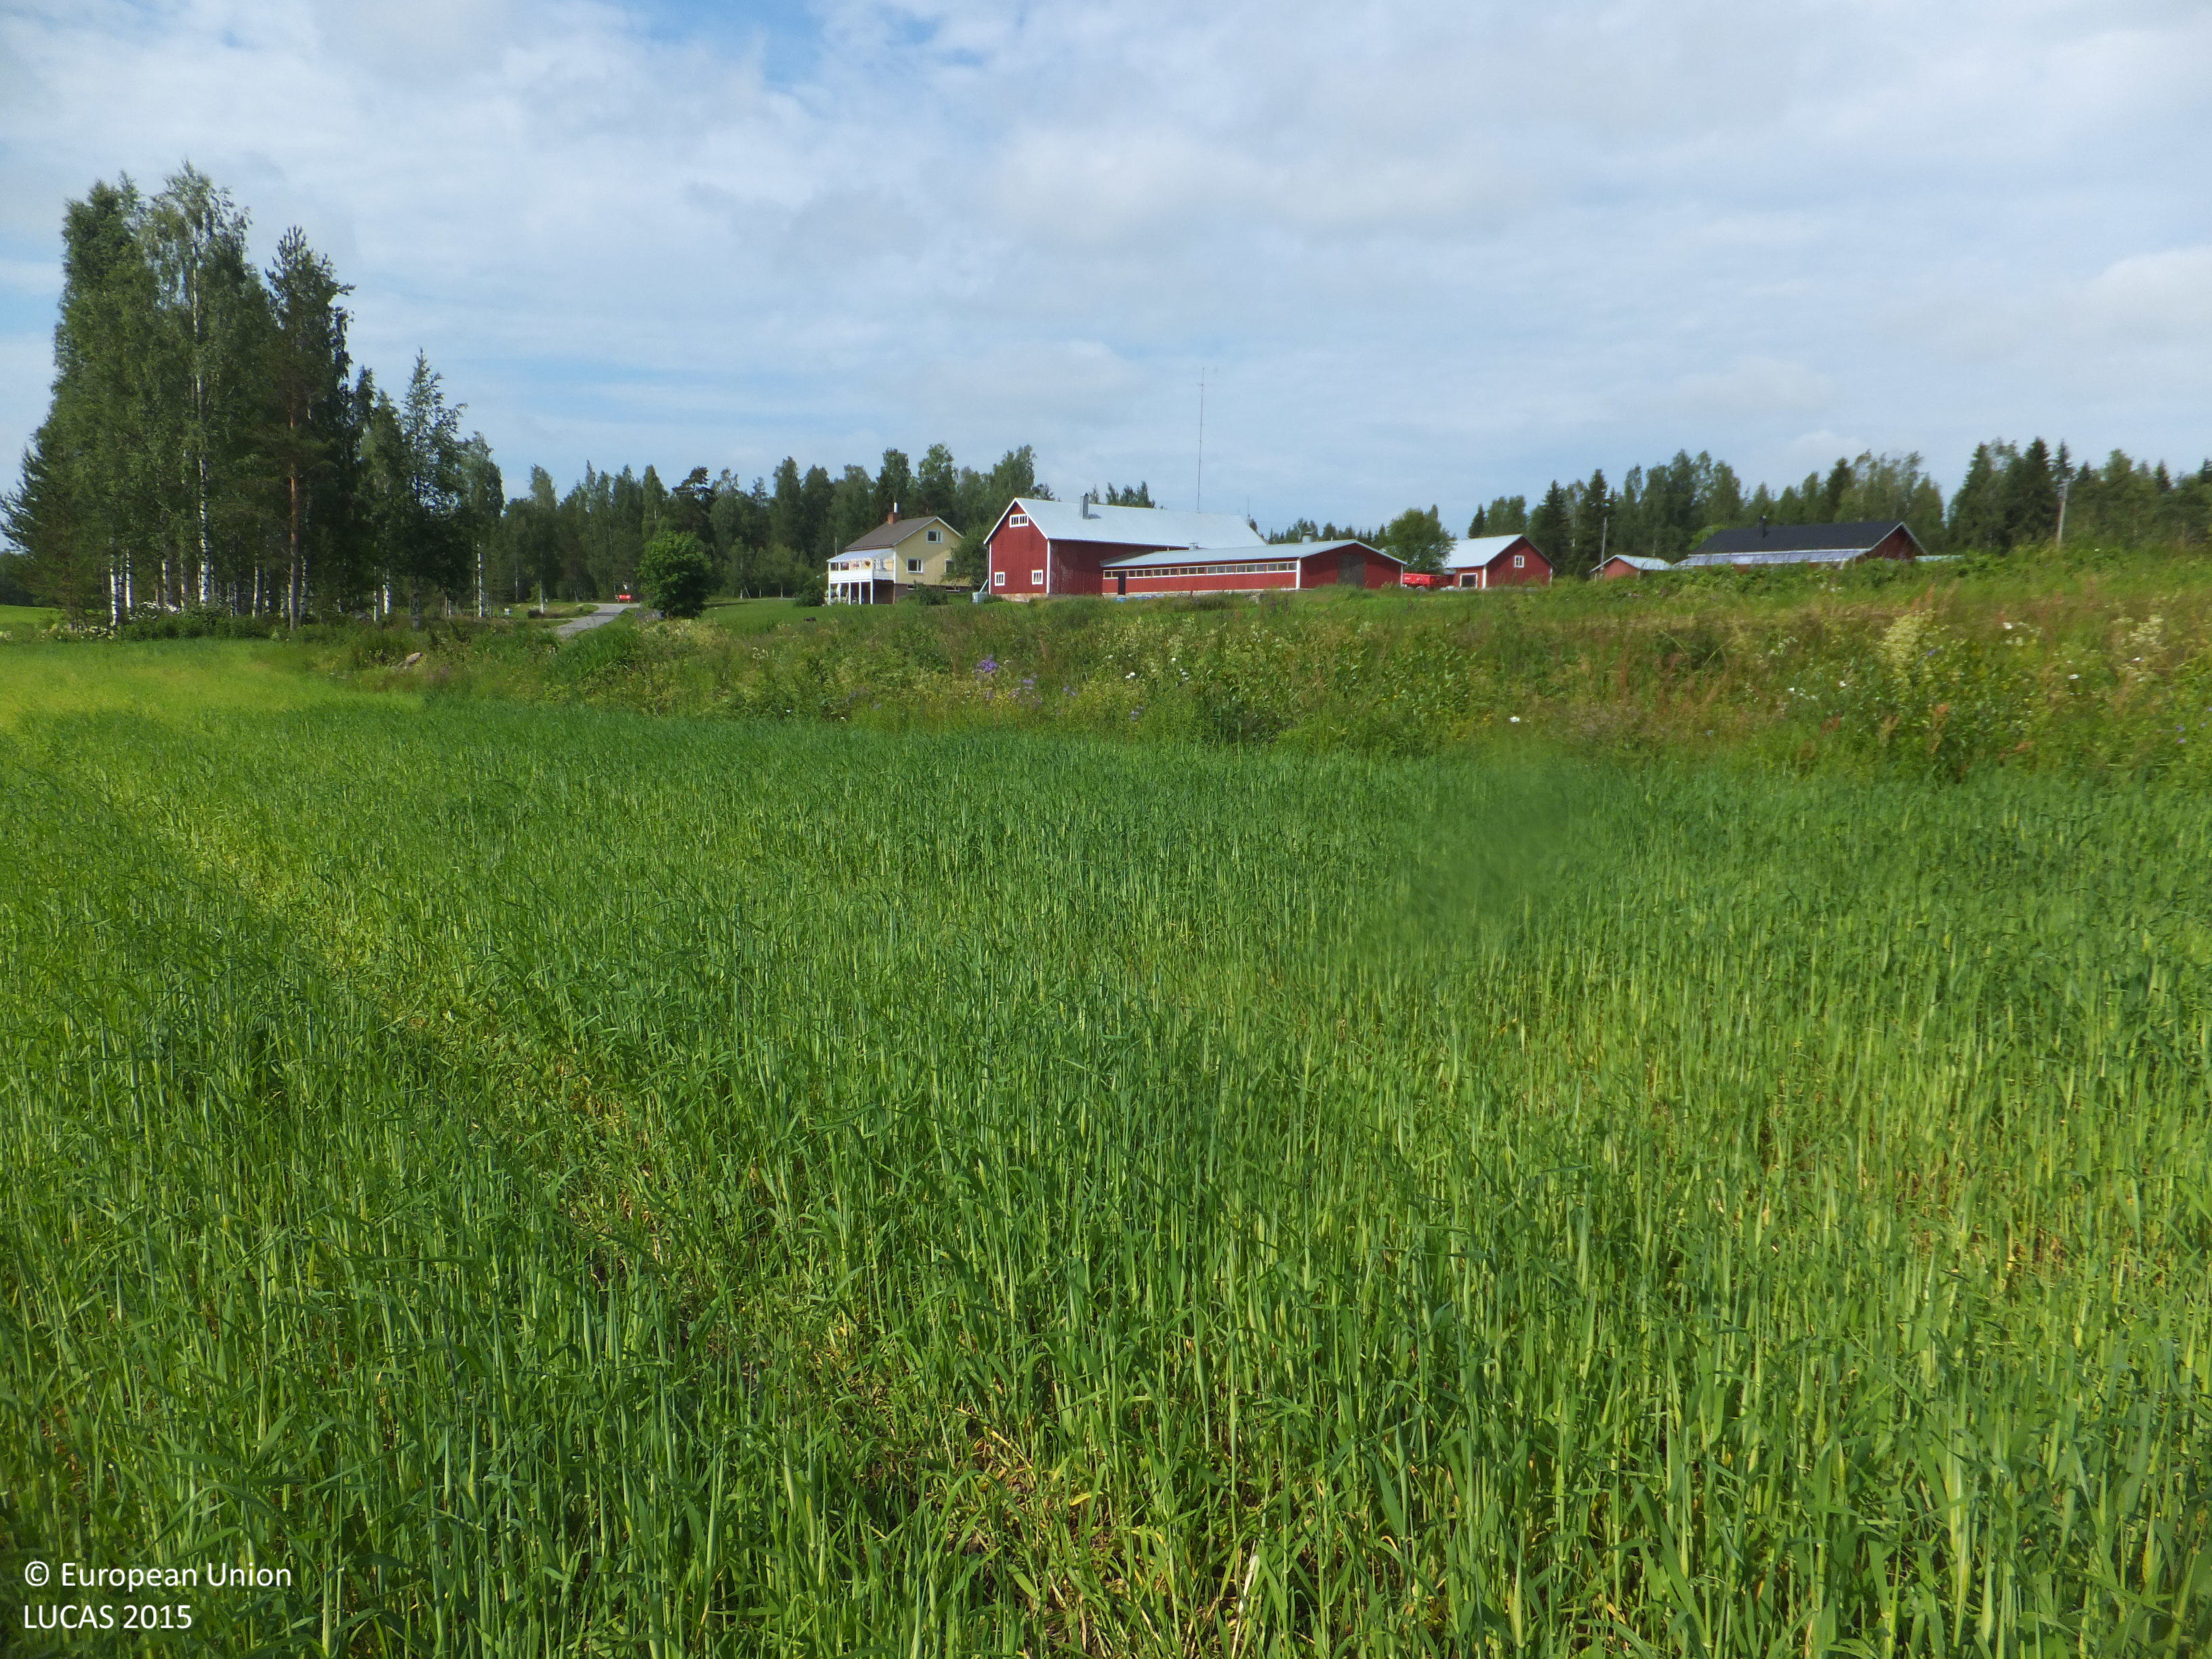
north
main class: Cropland
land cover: Barley
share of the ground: > 75 %
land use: Agriculture (excluding fallow land and kitchen gardens)
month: July
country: FI
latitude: 63.5748
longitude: 23.1266
